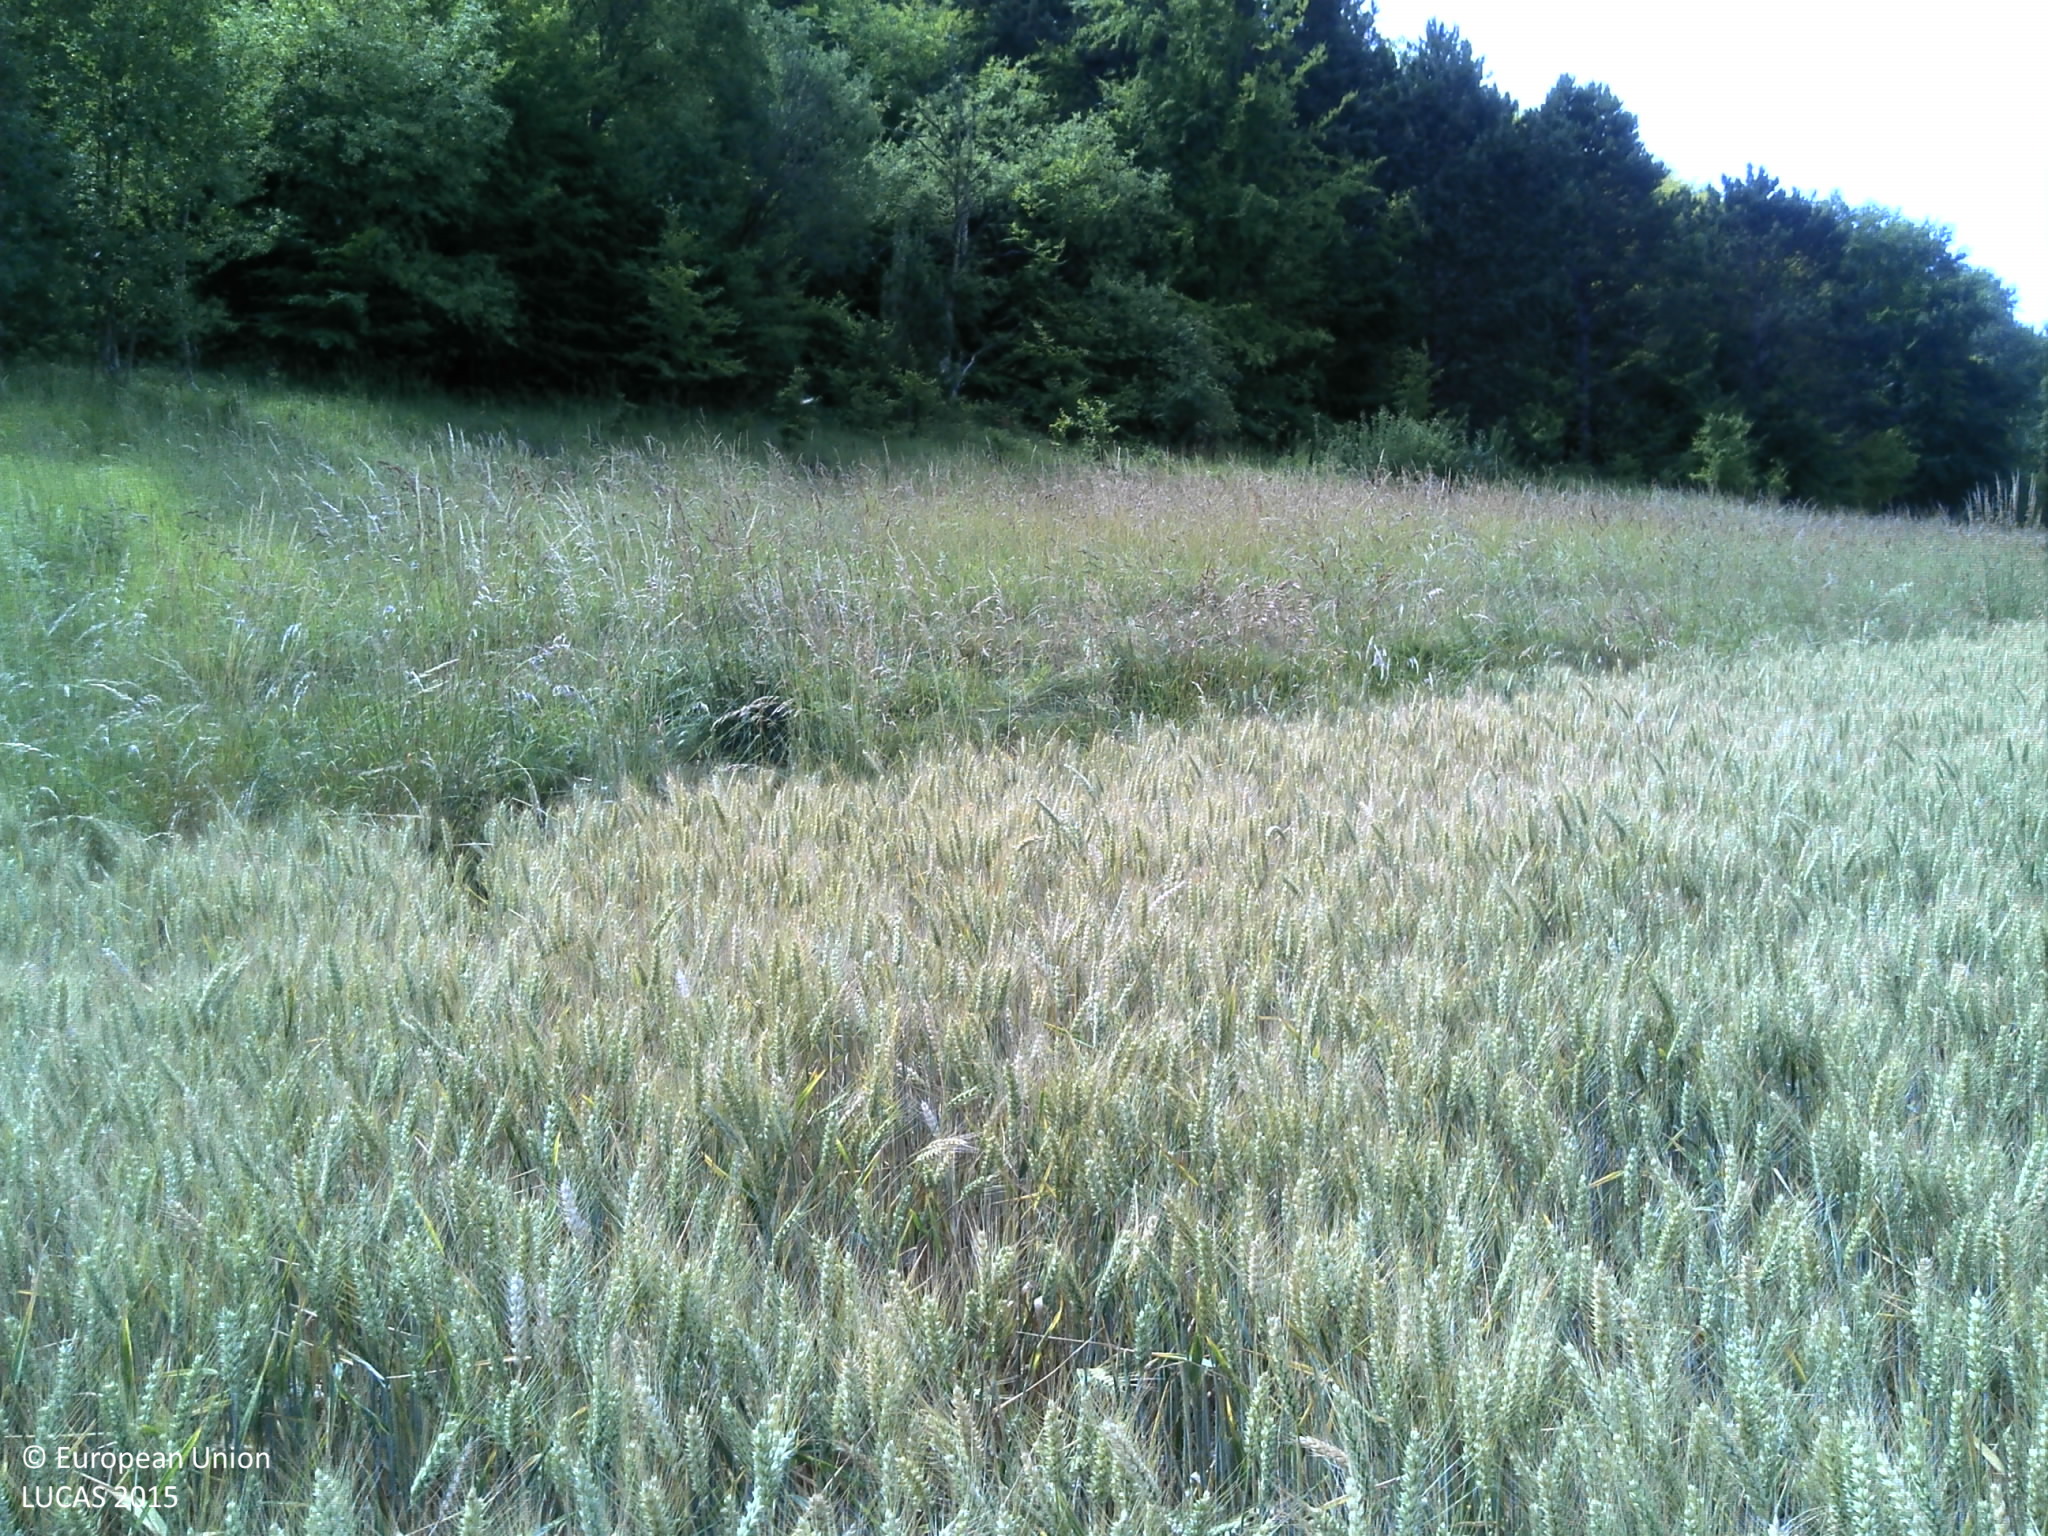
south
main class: Cropland
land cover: Durum wheat
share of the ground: > 75 %
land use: Agriculture (excluding fallow land and kitchen gardens)
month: July
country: FR
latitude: 49.8279
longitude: 1.7114
